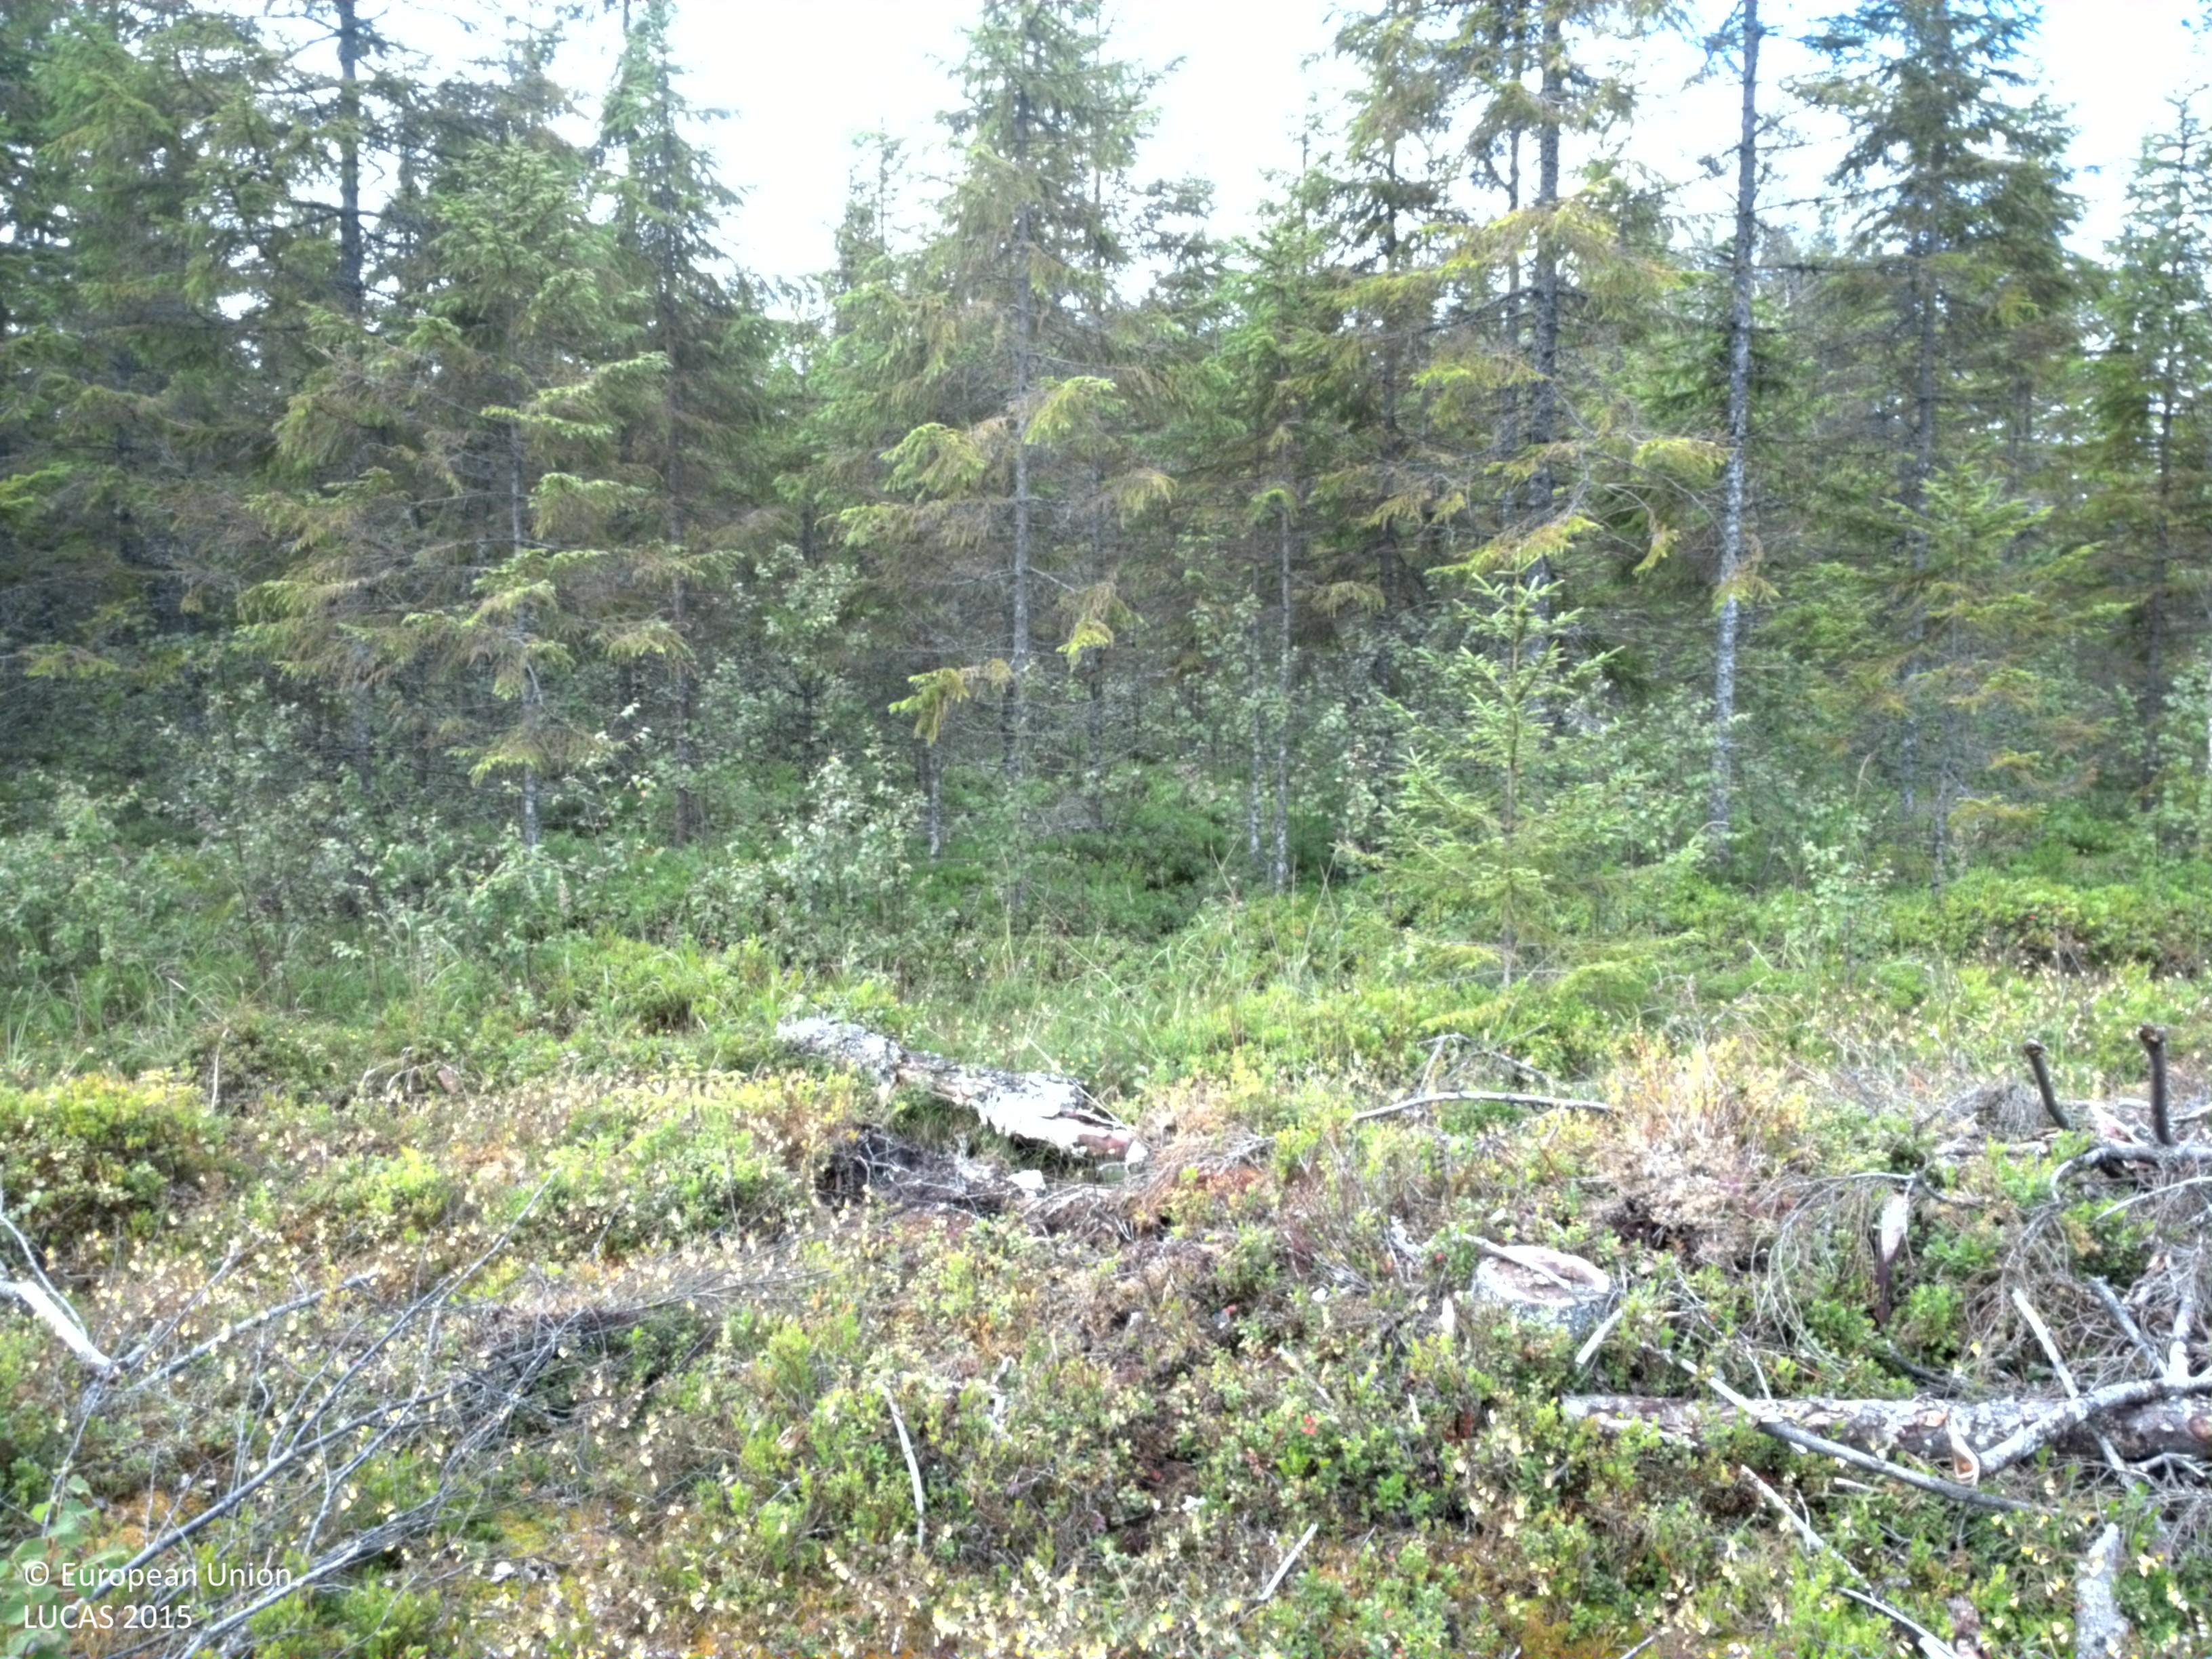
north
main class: Woodland
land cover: Broadleaved woodland
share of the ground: 10 - 25 %
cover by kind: shrubs 55 %, herbaceous plants 20 %, broadleaved forest trees 15 %, unconsolidated bare surface 10 %
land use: Forestry
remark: Clear cut
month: July
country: SE
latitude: 59.7508
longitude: 14.4217
